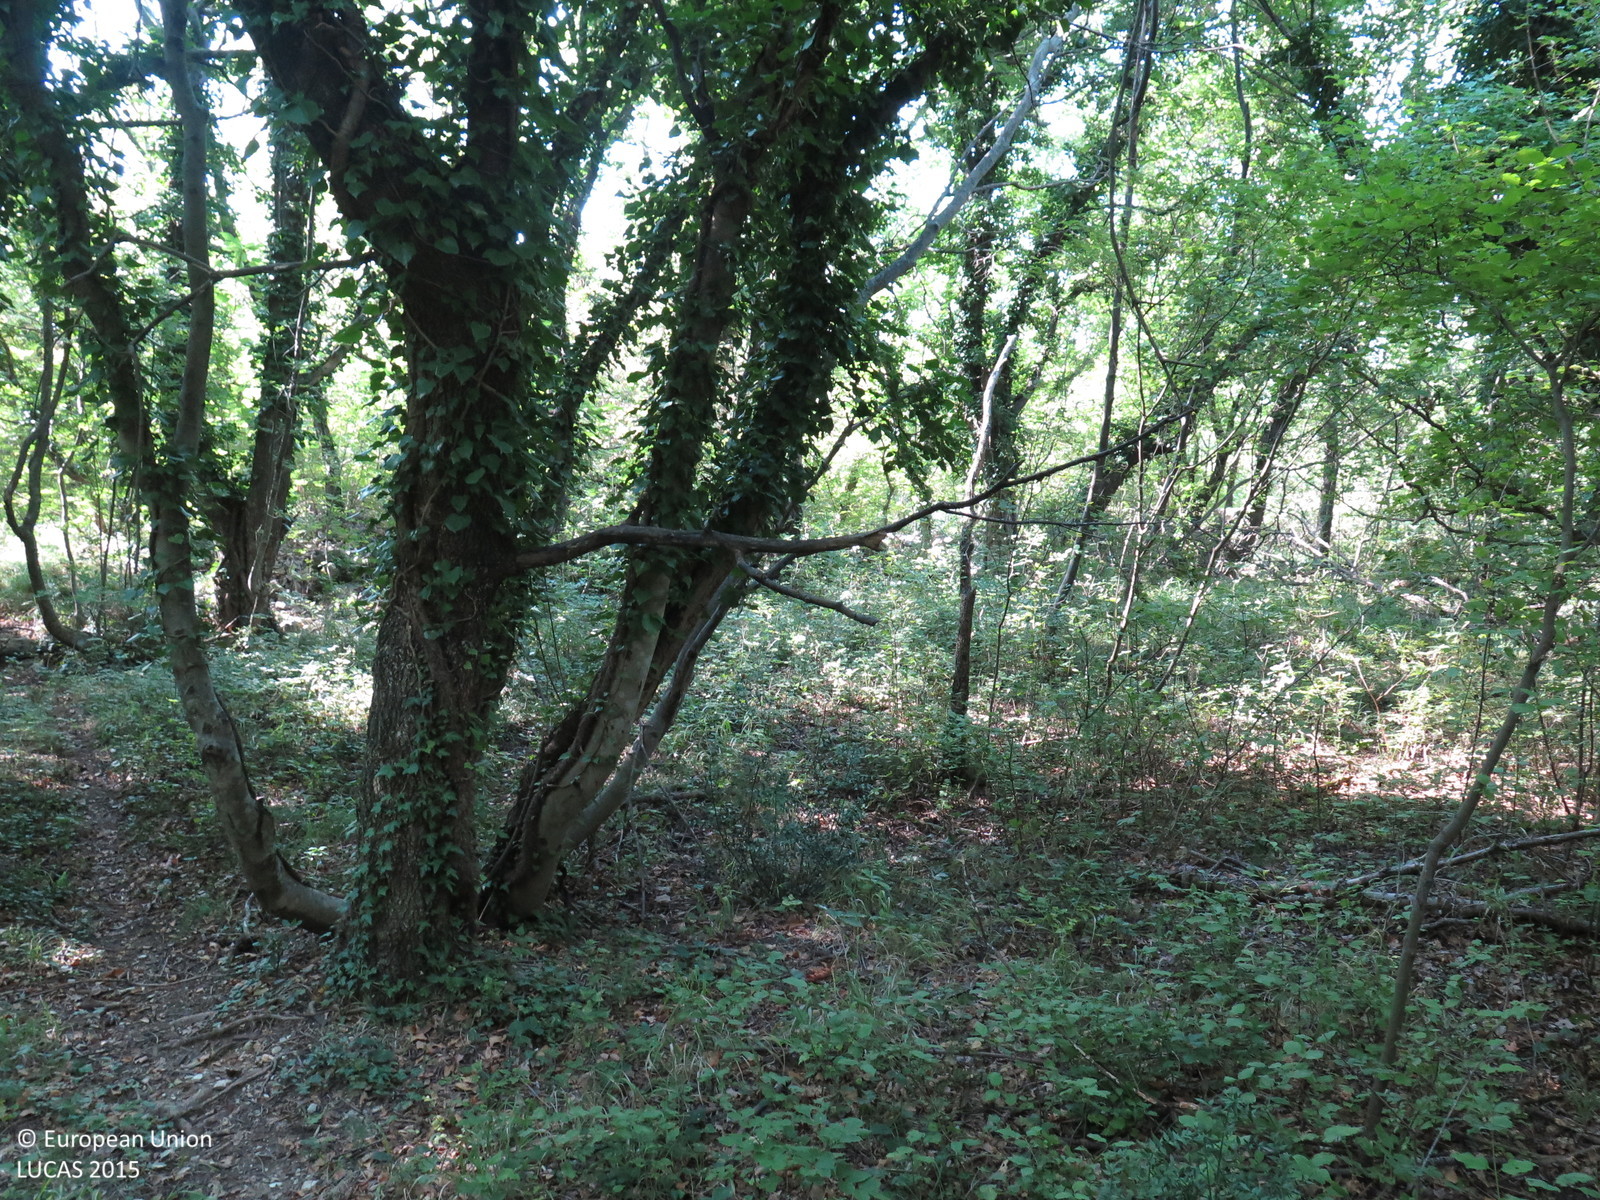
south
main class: Woodland
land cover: Broadleaved woodland
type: mesophytic deciduous forest
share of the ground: > 75 %
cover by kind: broadleaved forest trees 90 %, shrubs 5 %, herbaceous plants 5 %
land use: Semi-natural and natural areas not in use
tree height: > 5 m
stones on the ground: 25 - 50 %
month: August
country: HR
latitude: 45.2004
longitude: 14.7177
